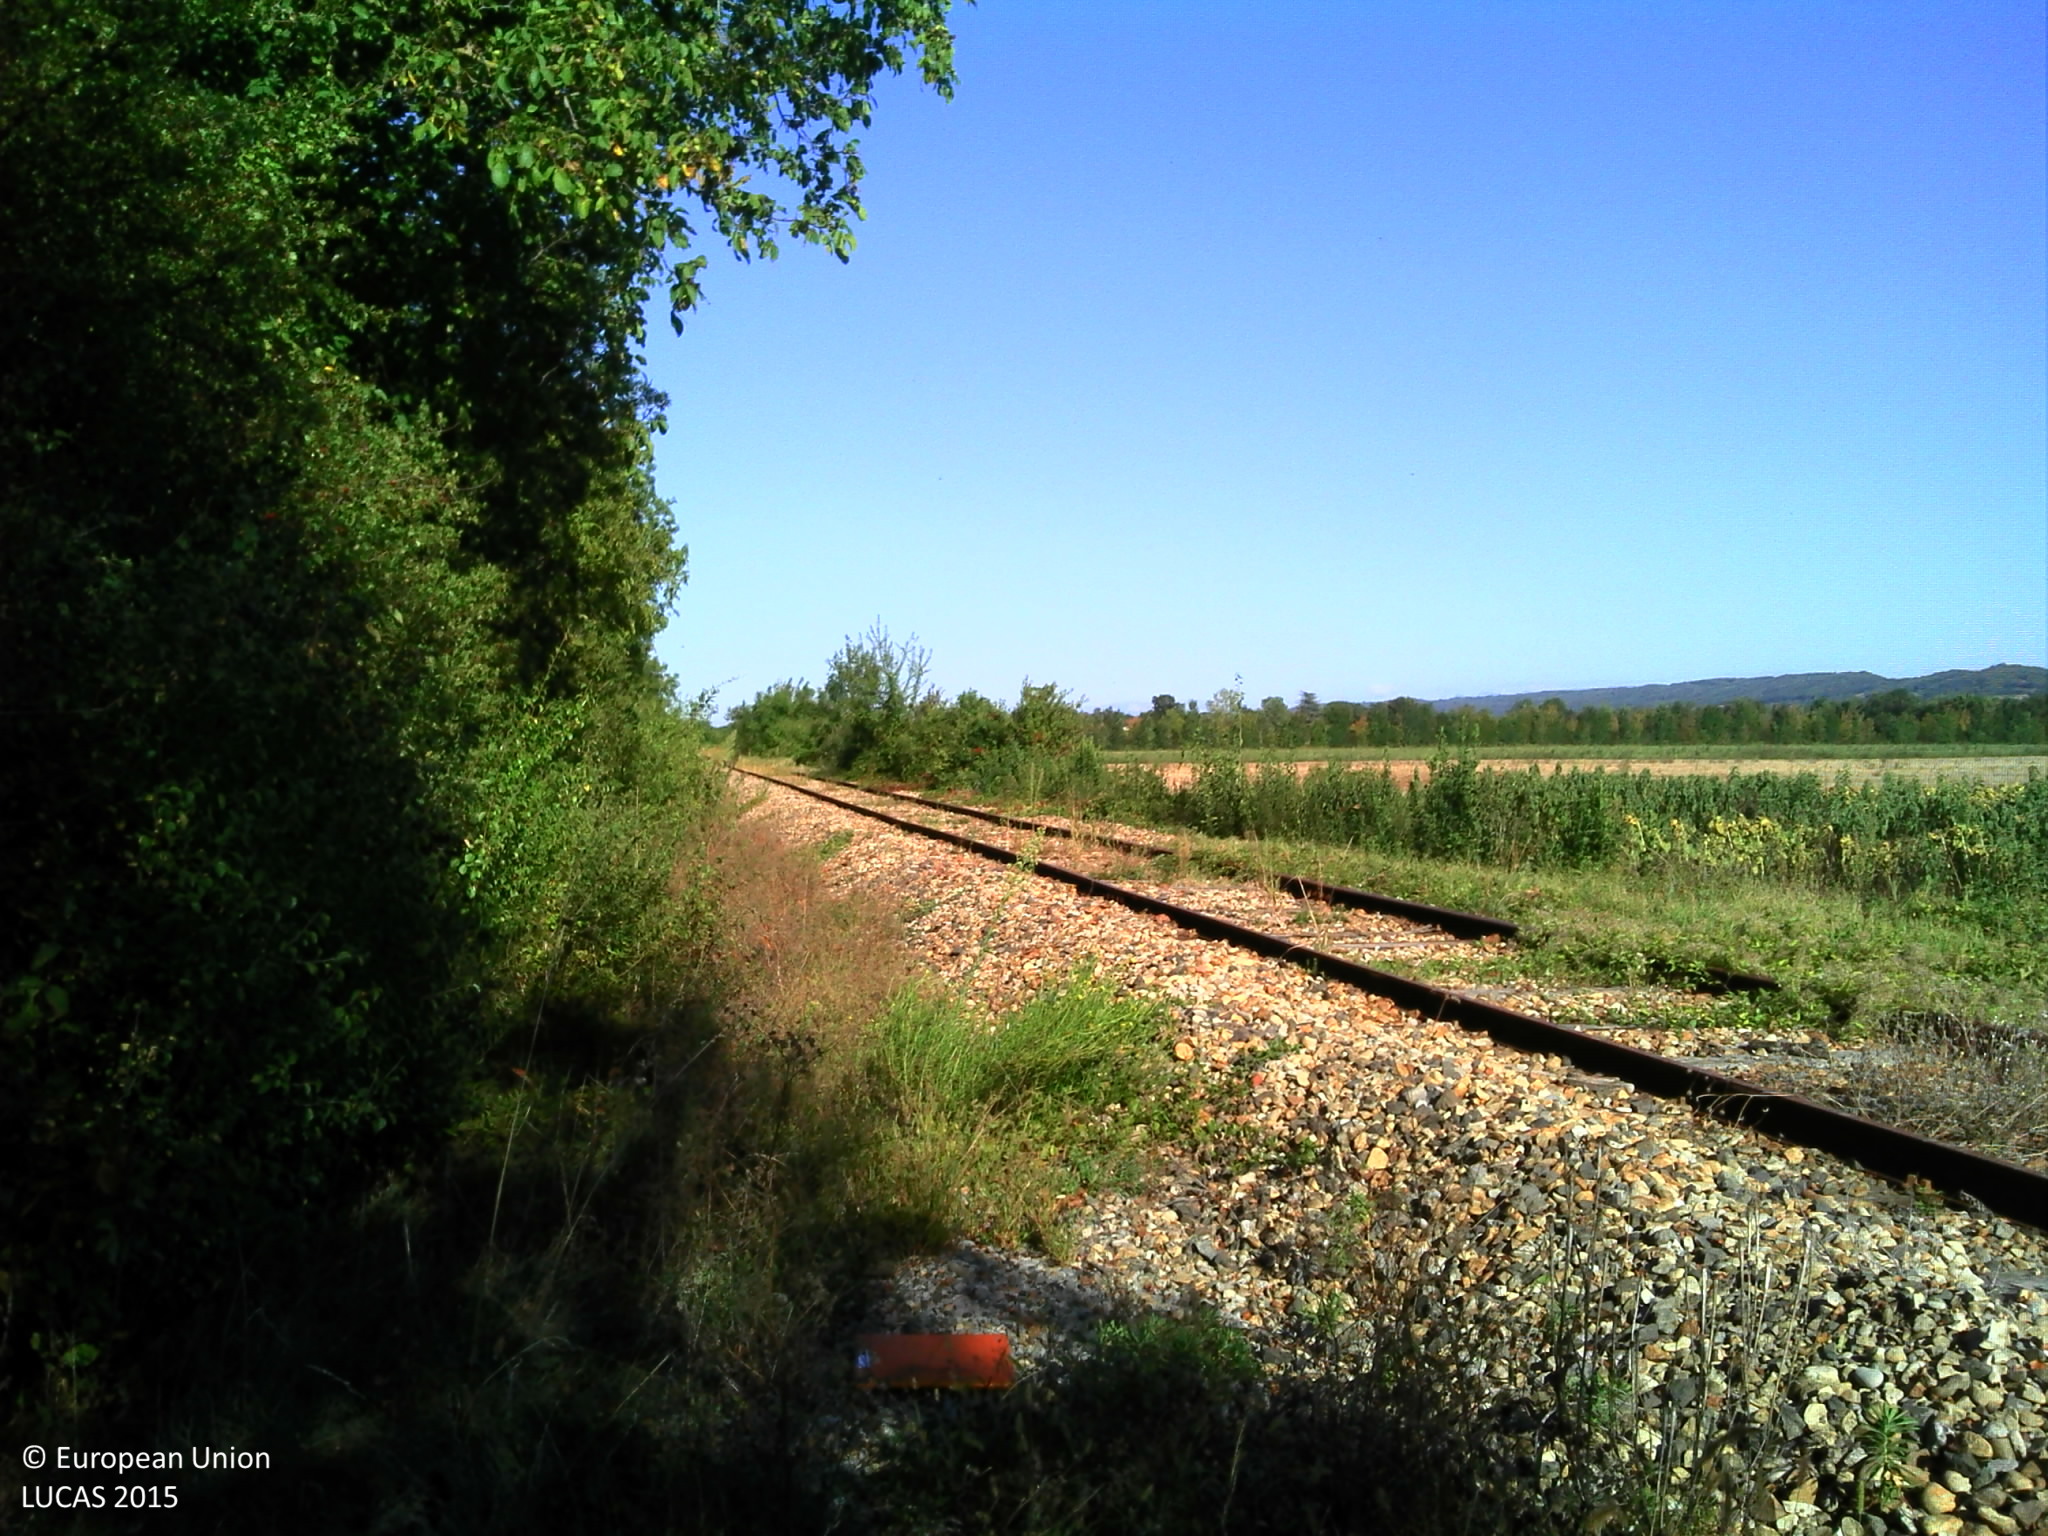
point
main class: Woodland
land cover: Broadleaved woodland
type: mesophytic deciduous forest
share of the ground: > 75 %
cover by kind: broadleaved forest trees 85 %, shrubs 10 %, coniferous forest trees 5 %
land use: Semi-natural and natural areas not in use
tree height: > 5 m
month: September
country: FR
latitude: 45.3134
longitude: 4.9919
